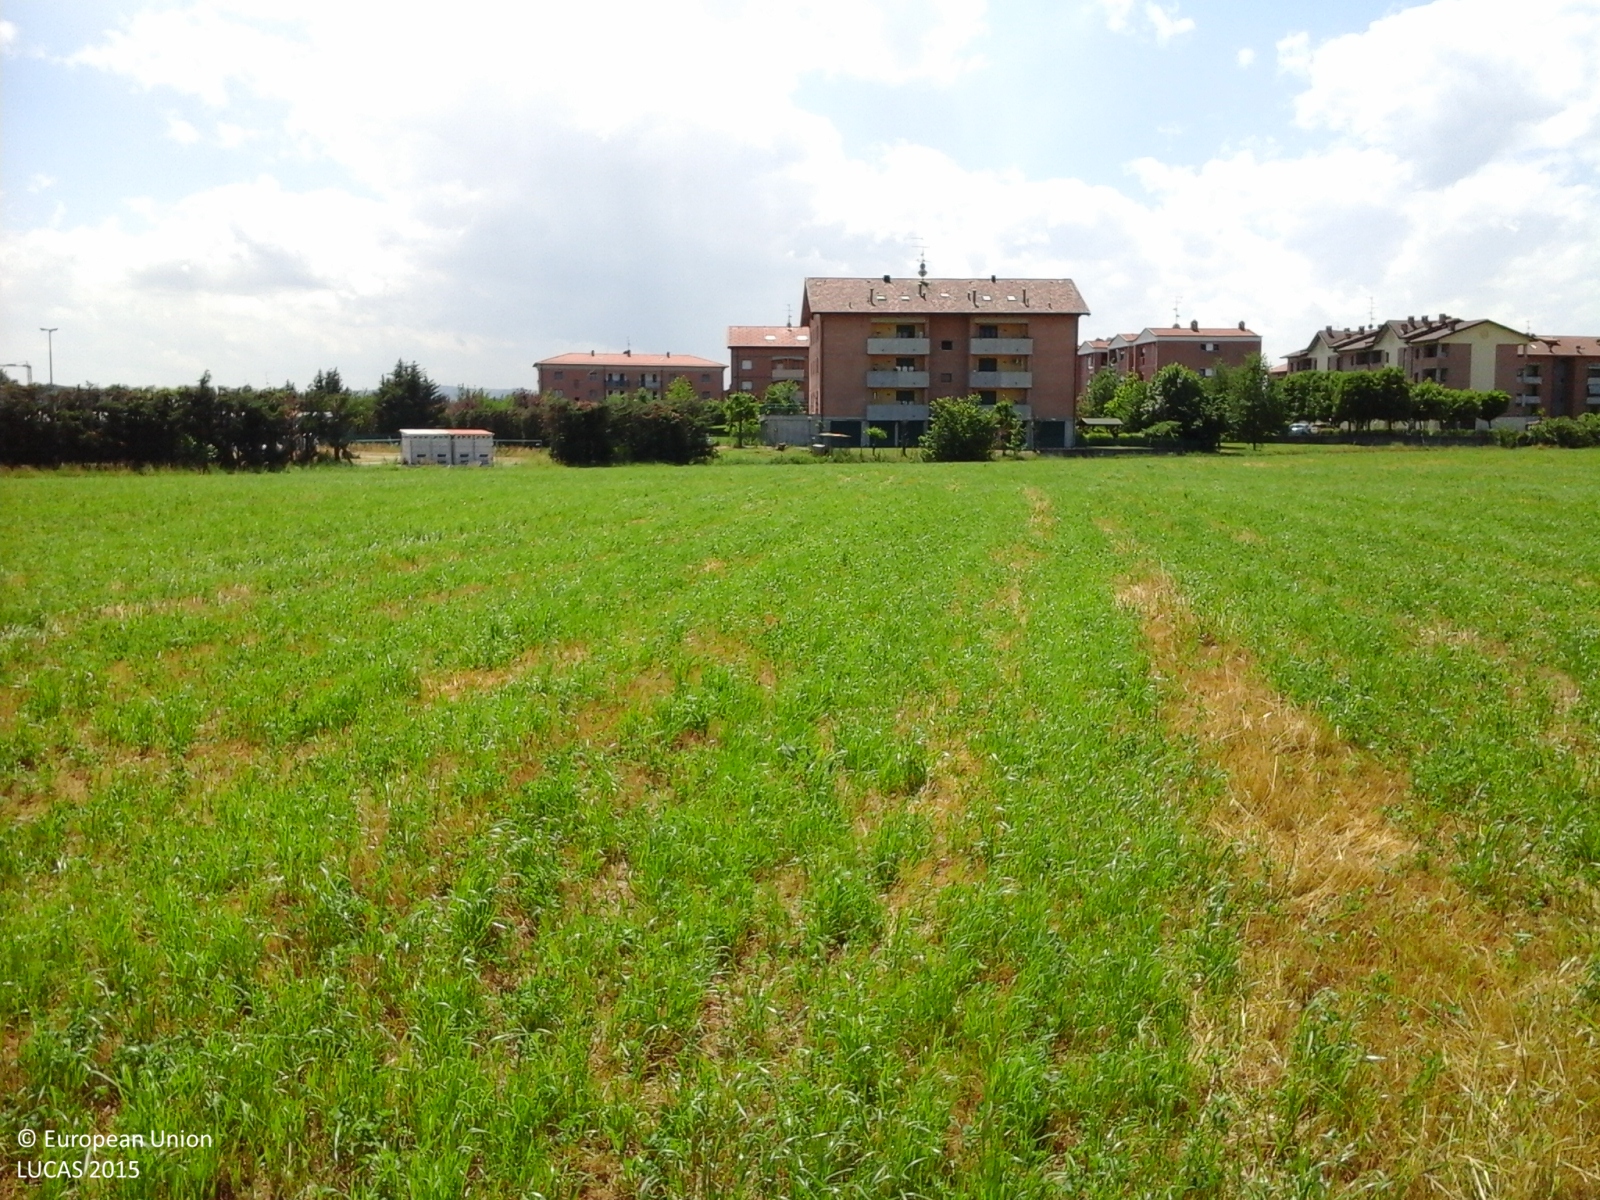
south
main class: Cropland
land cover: Lucerne
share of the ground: > 75 %
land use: Agriculture (excluding fallow land and kitchen gardens)
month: May
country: IT
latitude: 44.6552
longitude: 10.6418
